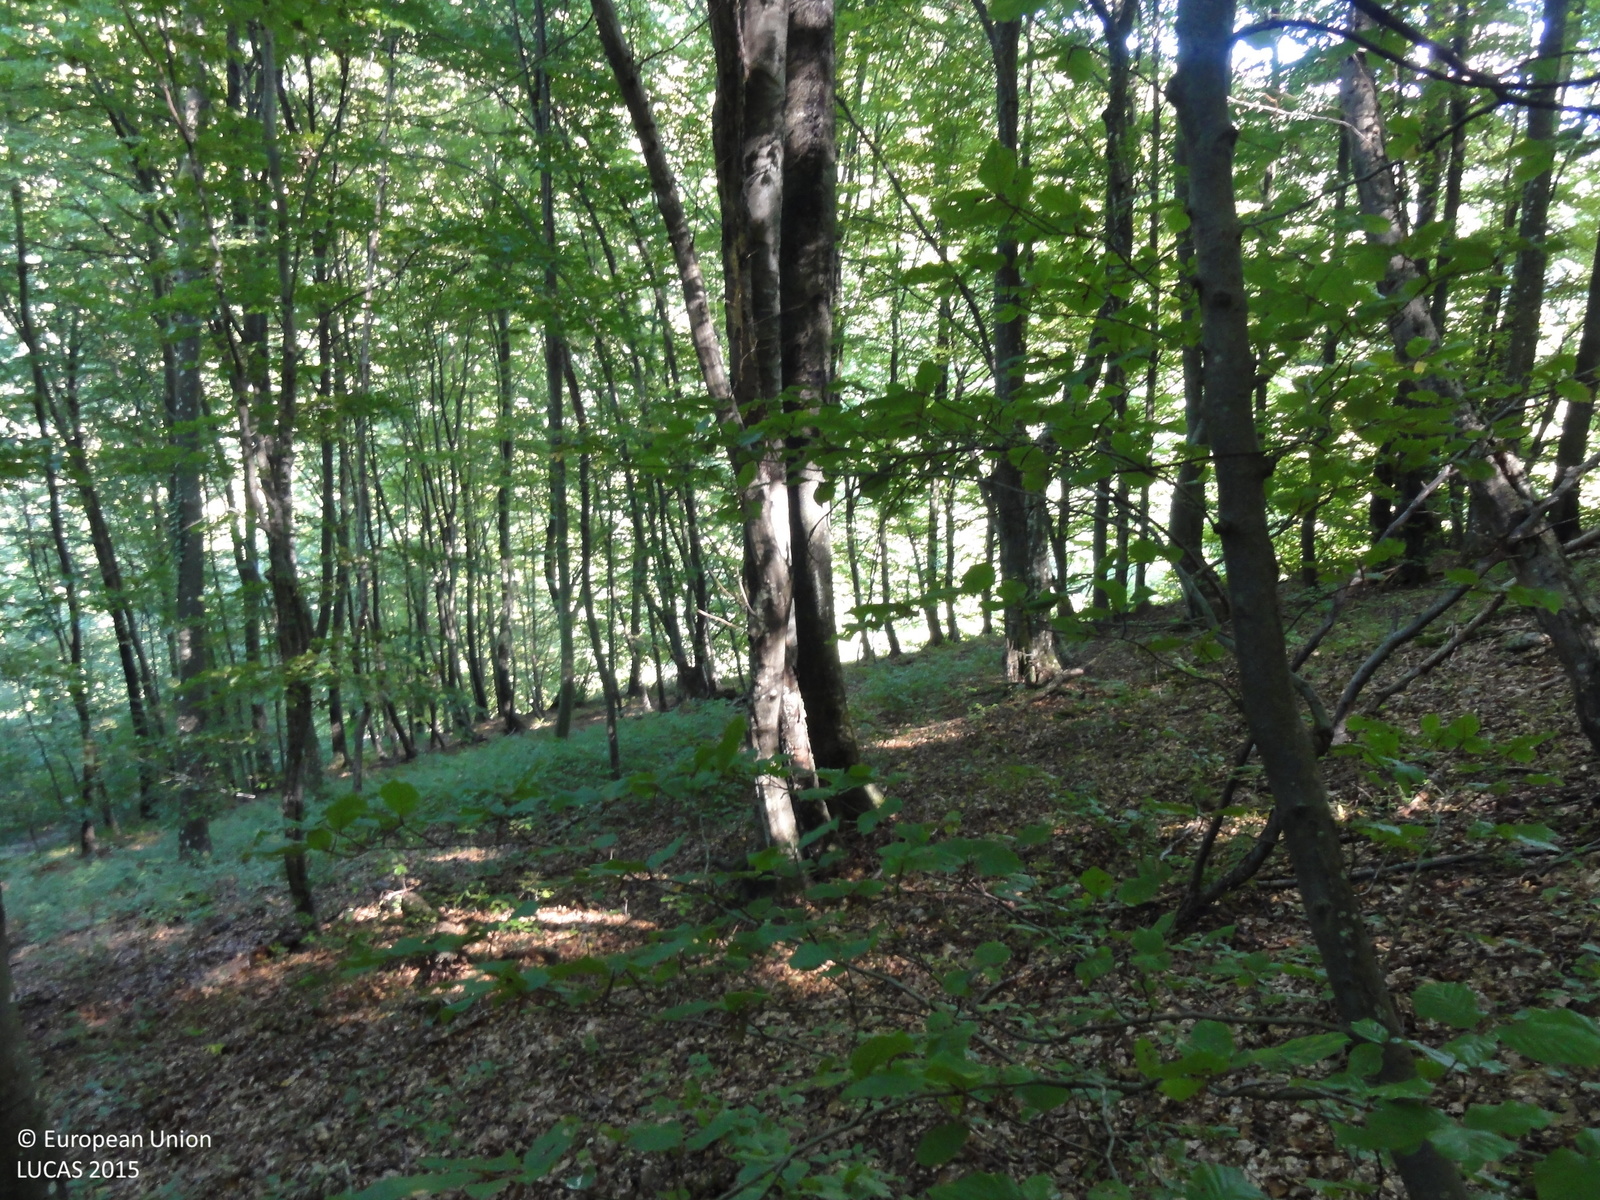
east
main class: Woodland
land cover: Broadleaved woodland
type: beech forest
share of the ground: > 75 %
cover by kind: broadleaved forest trees 100 %
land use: Forestry
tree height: > 5 m
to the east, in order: Broadleaved woodland; Grassland without tree/shrub cover; Shrubland without tree cover; Tracks; Broadleaved woodland; Inland fresh running water; Broadleaved woodland; Grassland without tree/shrub cover; Broadleaved woodland
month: September
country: SI
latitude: 45.8143
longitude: 15.4665
